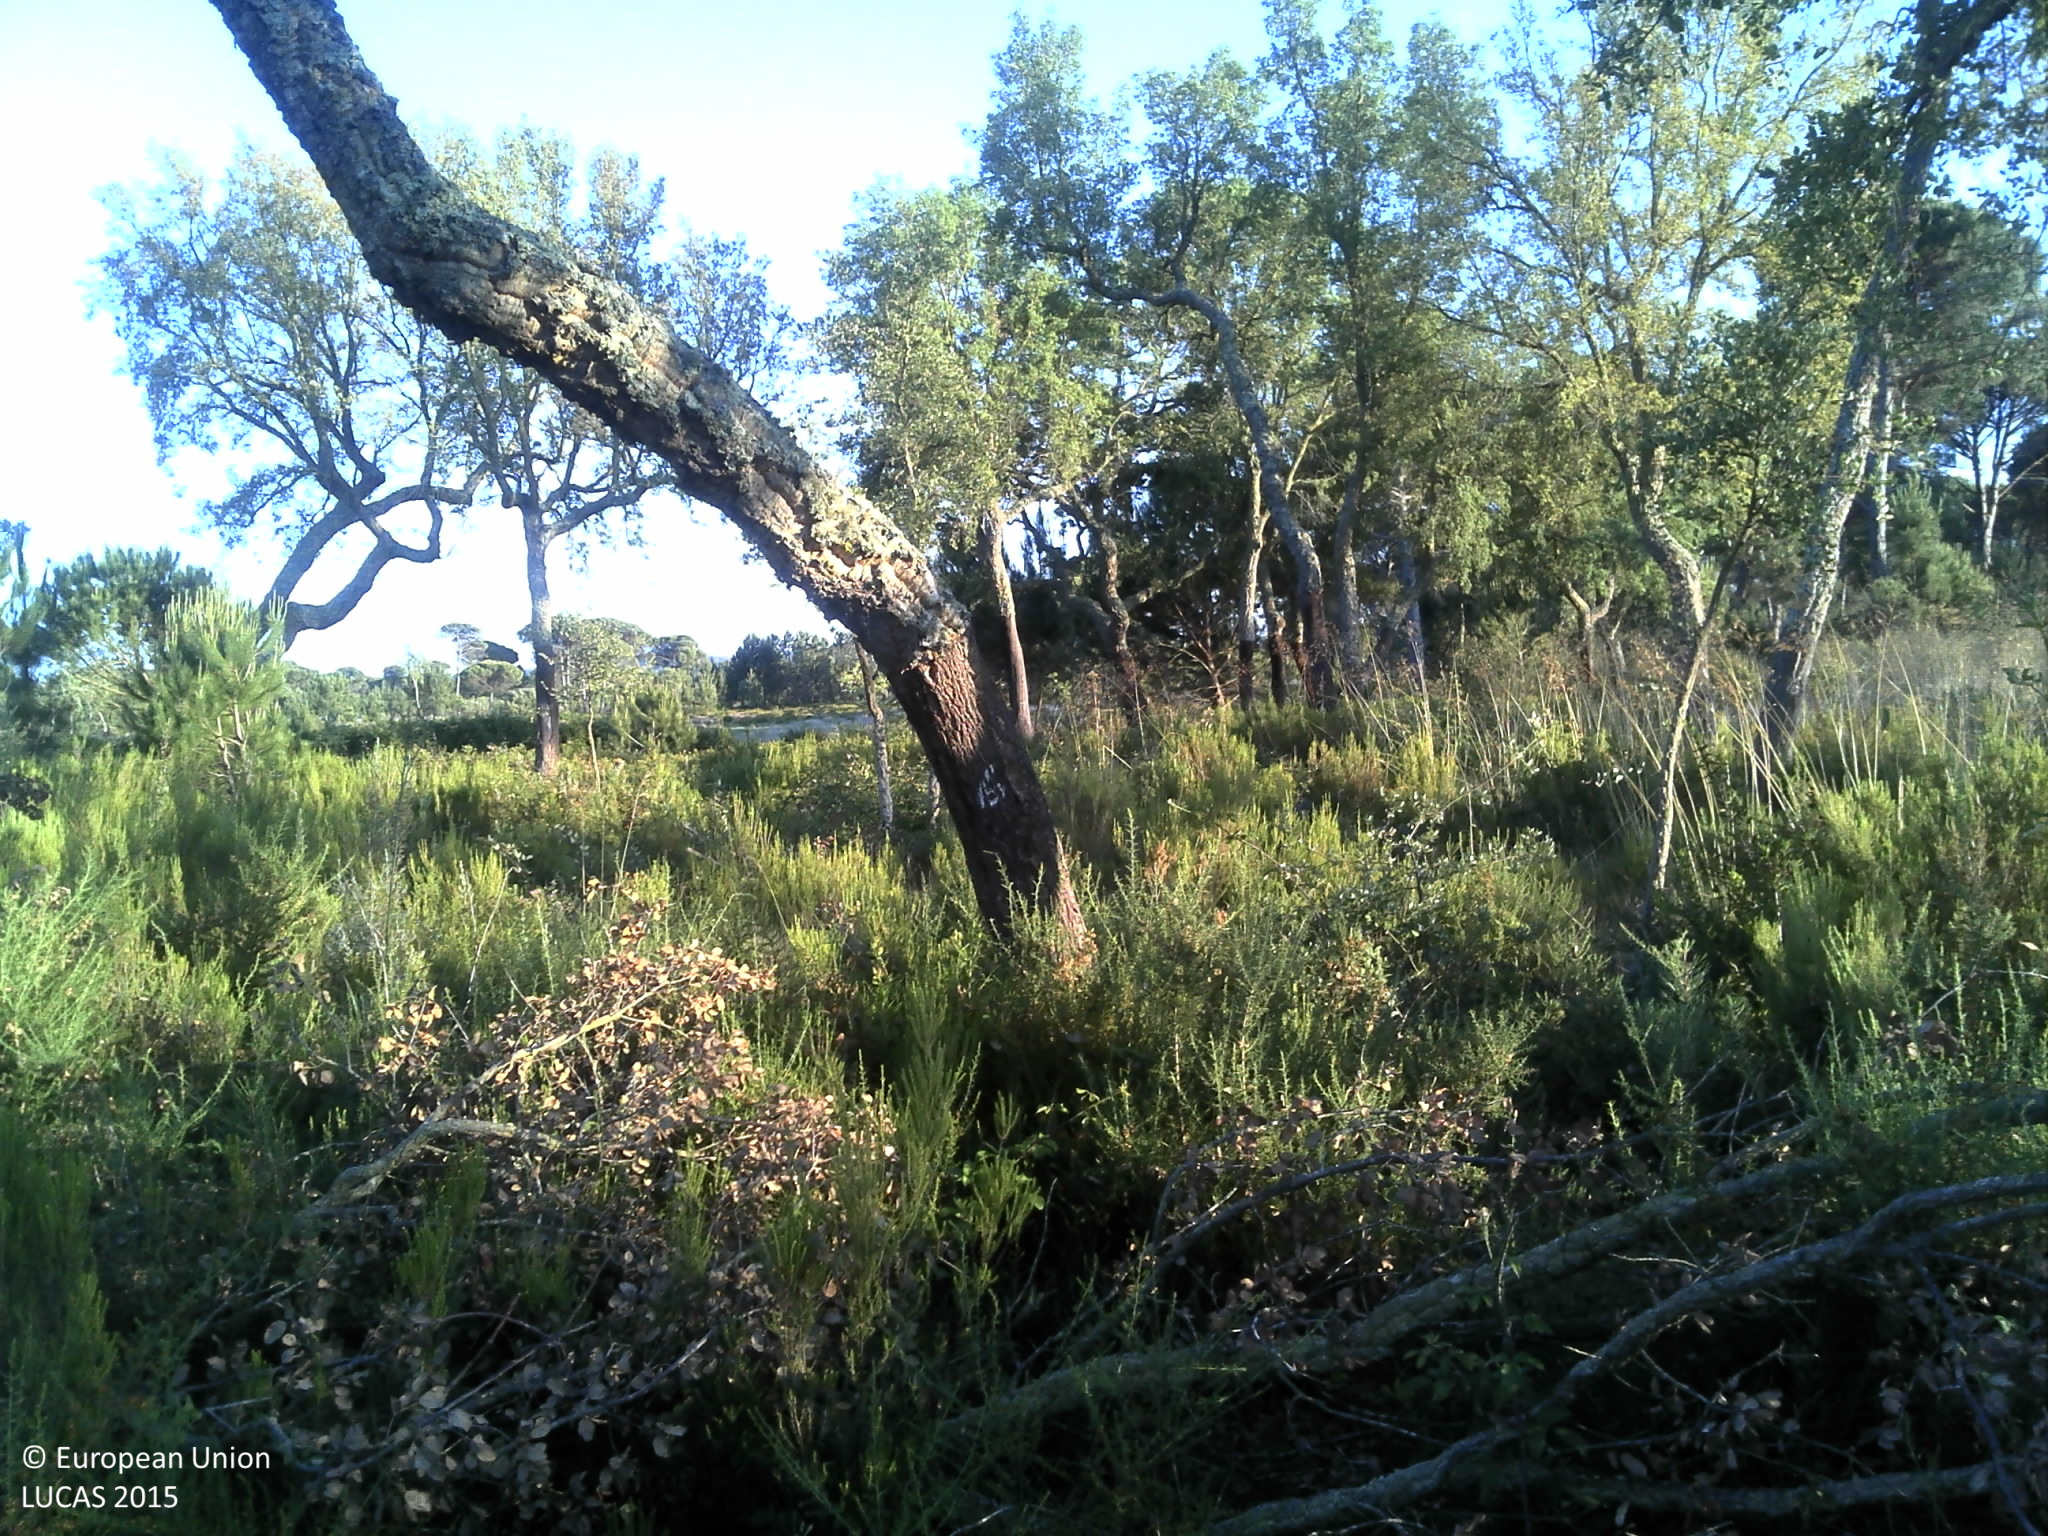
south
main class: Woodland
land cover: Broadleaved woodland
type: broadleaved evergreen forest
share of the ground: 25 - 50 %
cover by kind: broadleaved forest trees 60 %, shrubs 30 %, herbaceous plants 5 %, unconsolidated bare surface 5 %
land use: Forestry
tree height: > 5 m
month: May
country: PT
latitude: 38.2231
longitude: -8.6358
